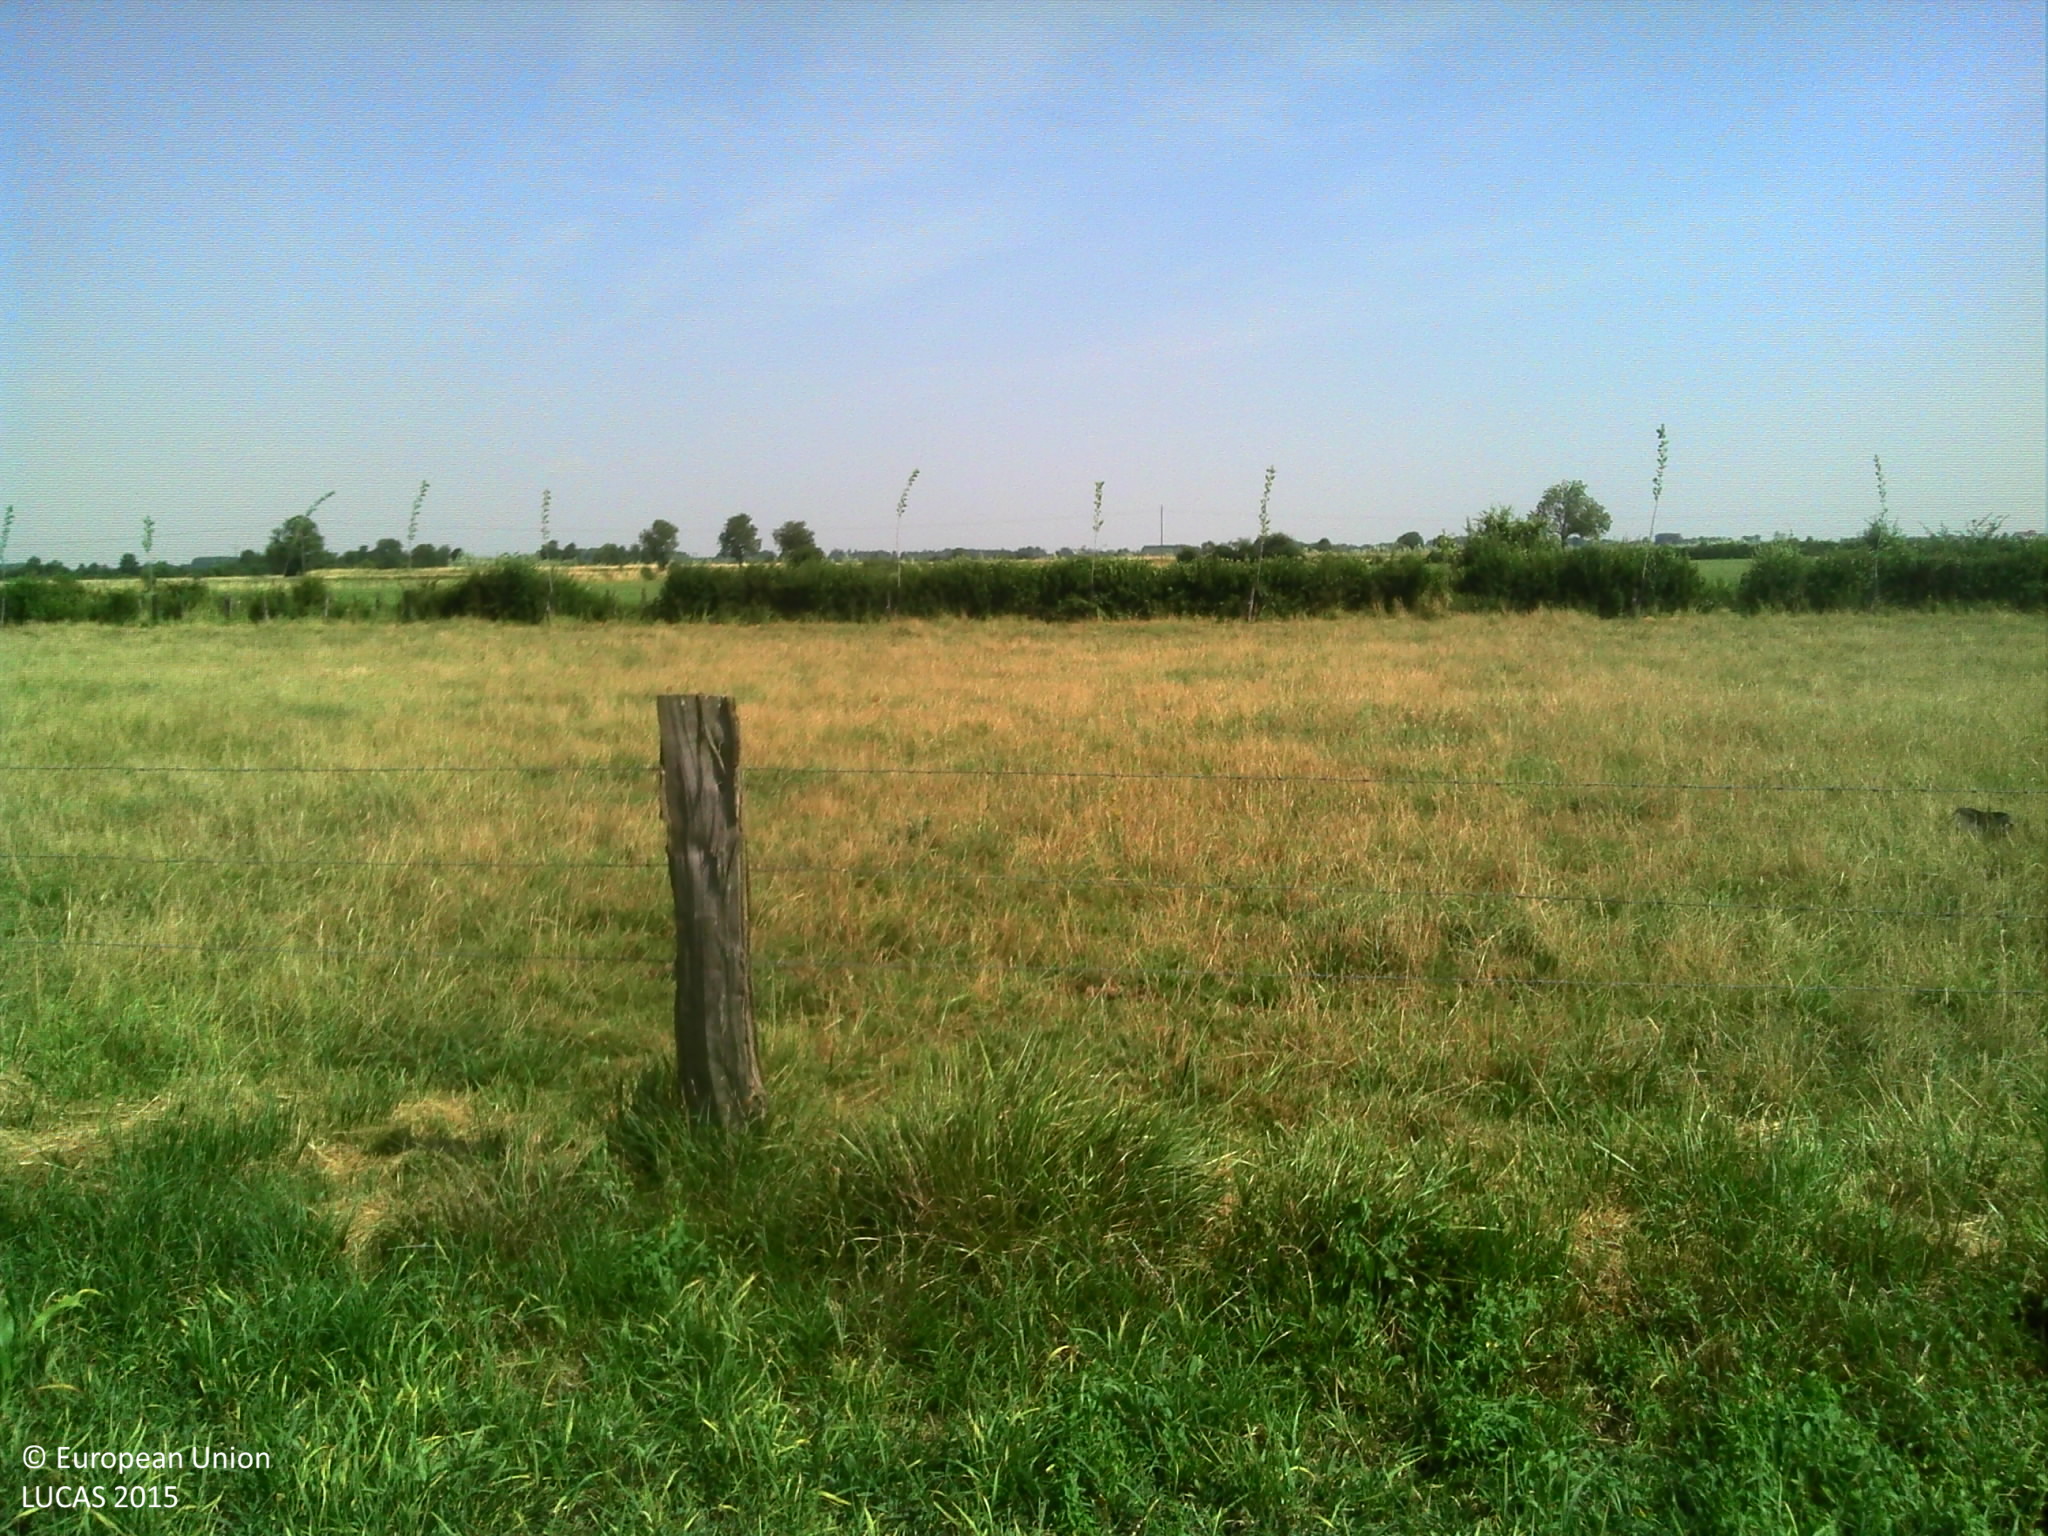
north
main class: Cropland
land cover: Maize
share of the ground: 50 - 75 %
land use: Agriculture (excluding fallow land and kitchen gardens)
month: July
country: FR
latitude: 46.8946
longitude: 5.2371
